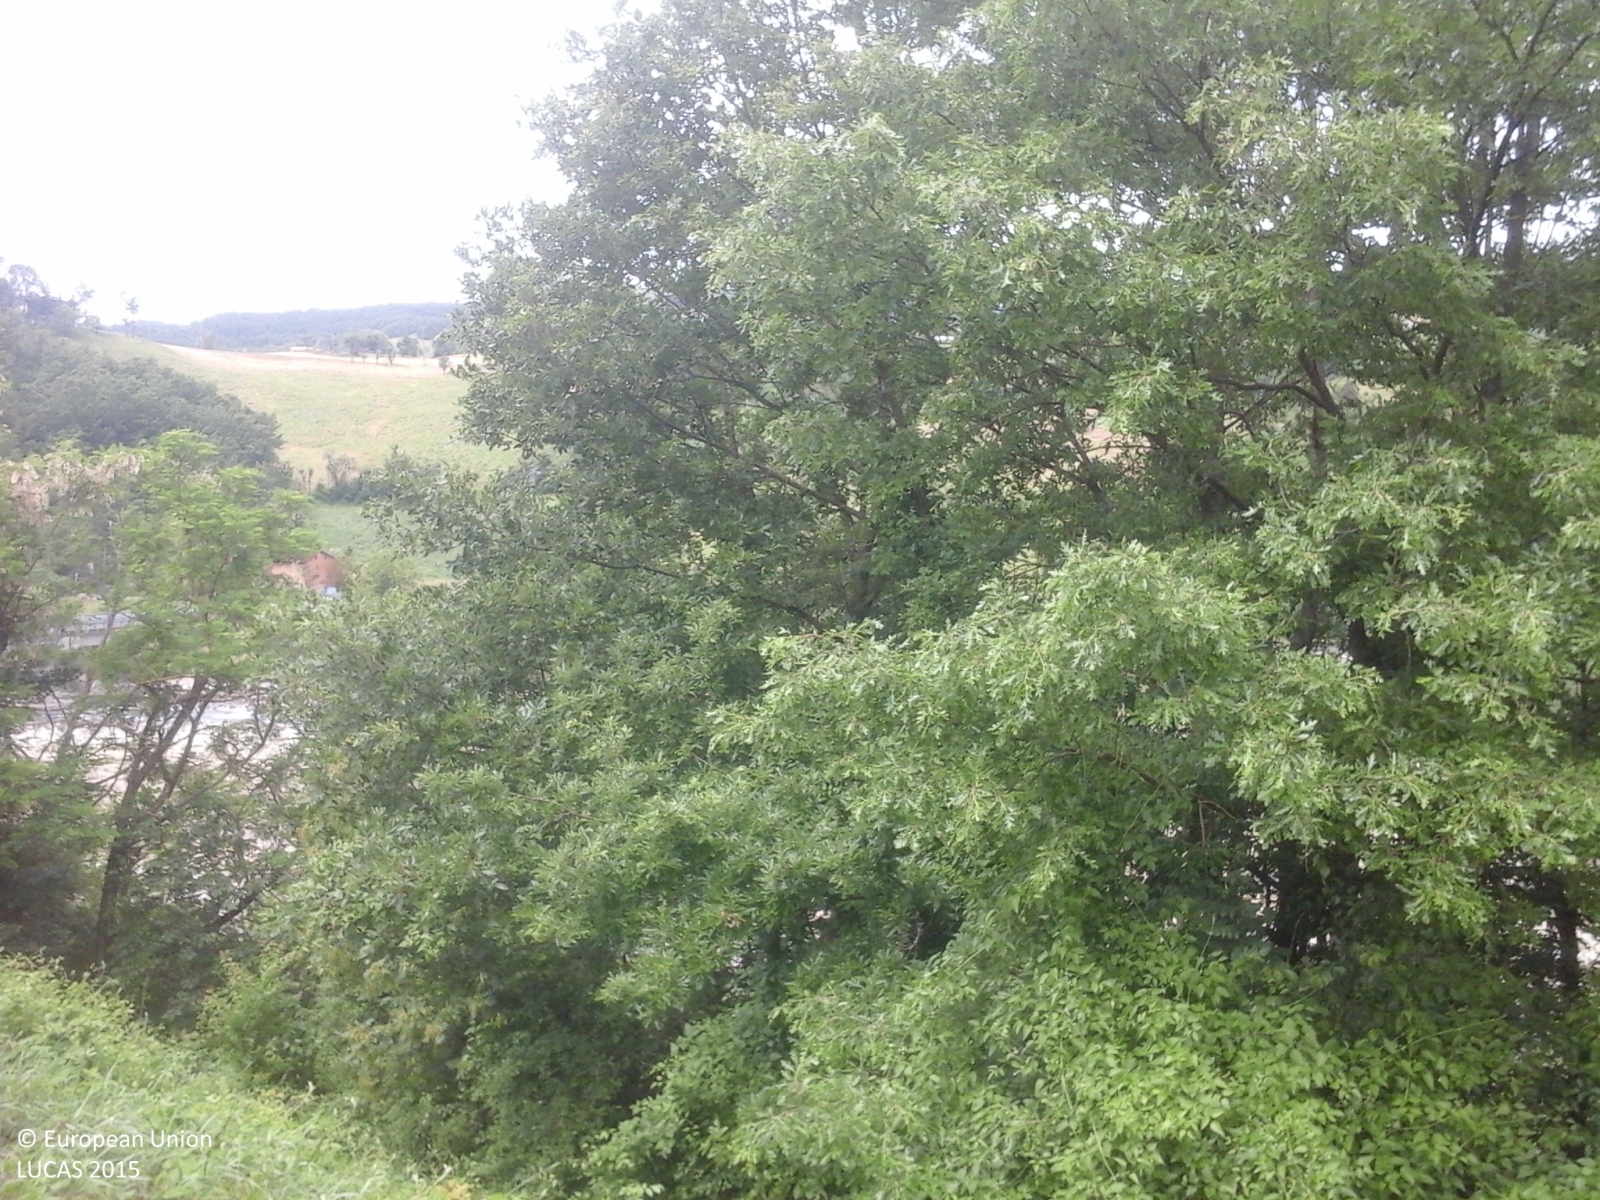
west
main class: Woodland
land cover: Broadleaved woodland
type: thermophilous deciduous forest
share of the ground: > 75 %
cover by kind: broadleaved forest trees 90 %, shrubs 10 %
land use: Semi-natural and natural areas not in use
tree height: > 5 m
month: May
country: IT
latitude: 44.2926
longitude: 10.8878
